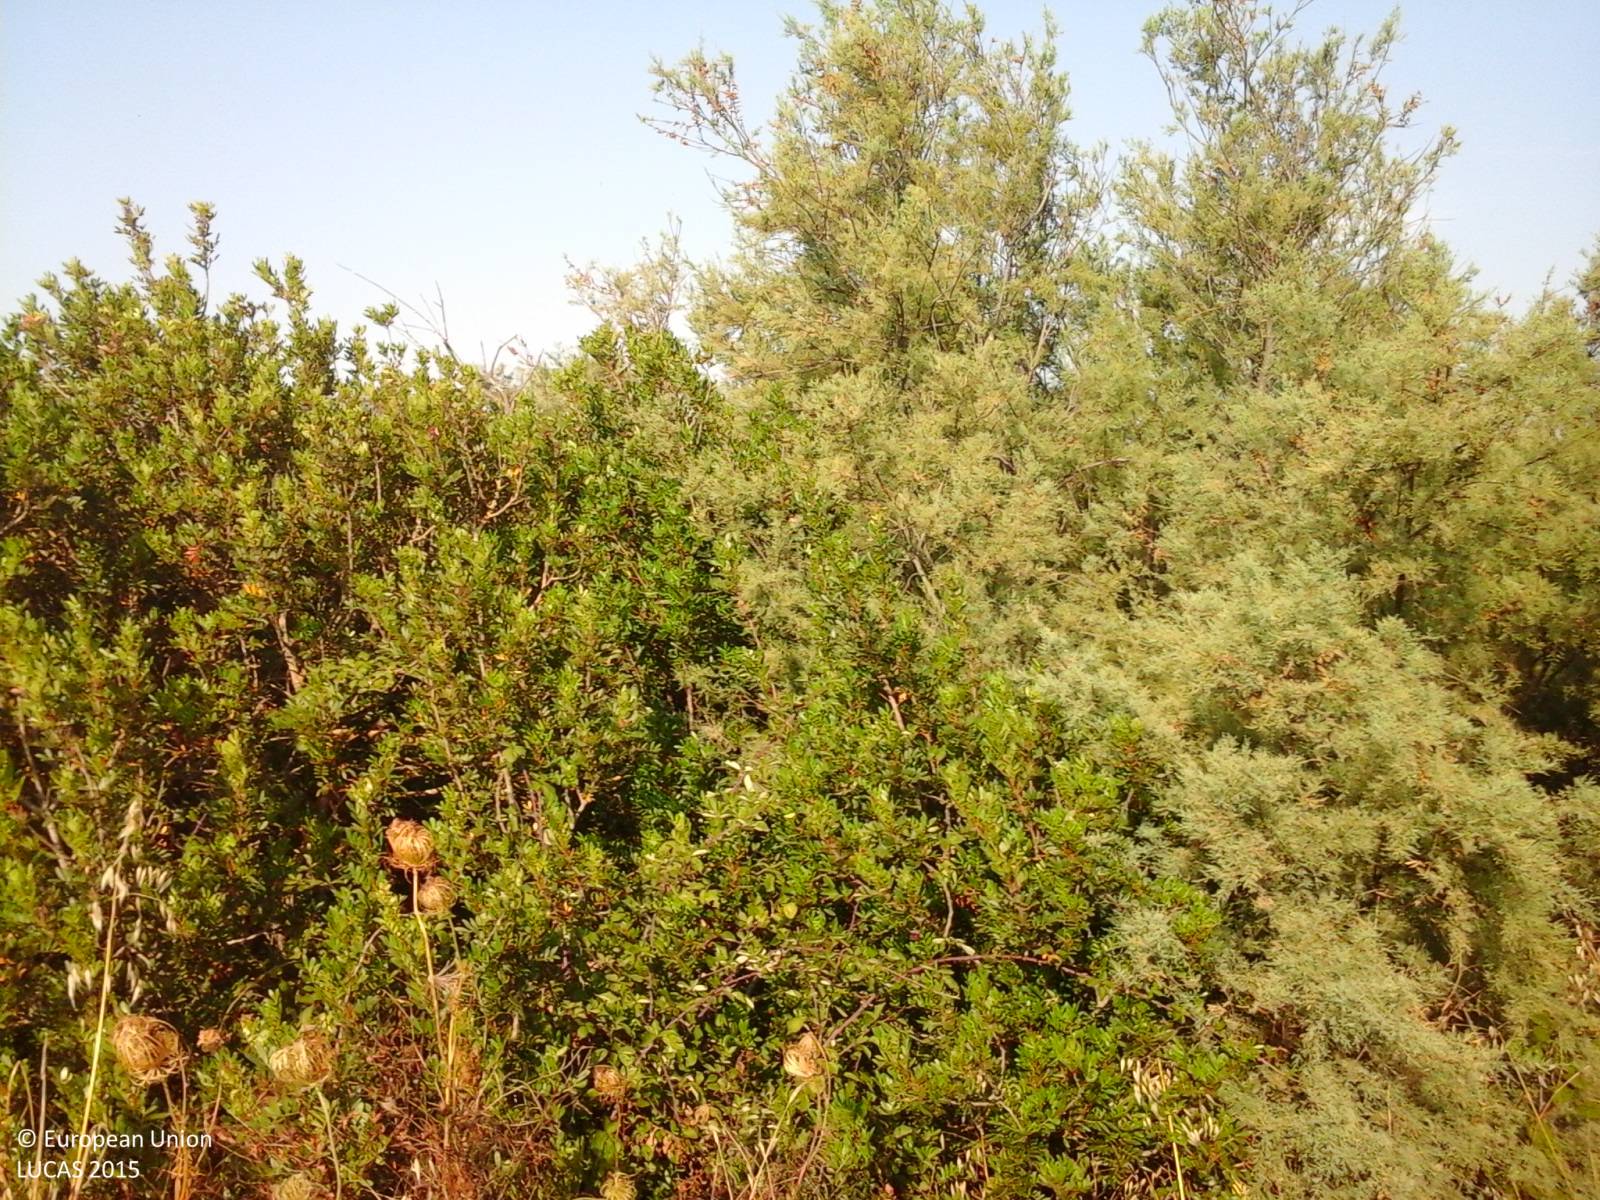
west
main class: Shrubland
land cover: Shrubland with sparse tree cover
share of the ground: > 75 %
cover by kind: herbaceous plants 80 %, shrubs 15 %, broadleaved forest trees 5 %
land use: Agriculture (excluding fallow land and kitchen gardens)
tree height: < 5 m
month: July
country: IT
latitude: 40.8222
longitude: 8.9026
